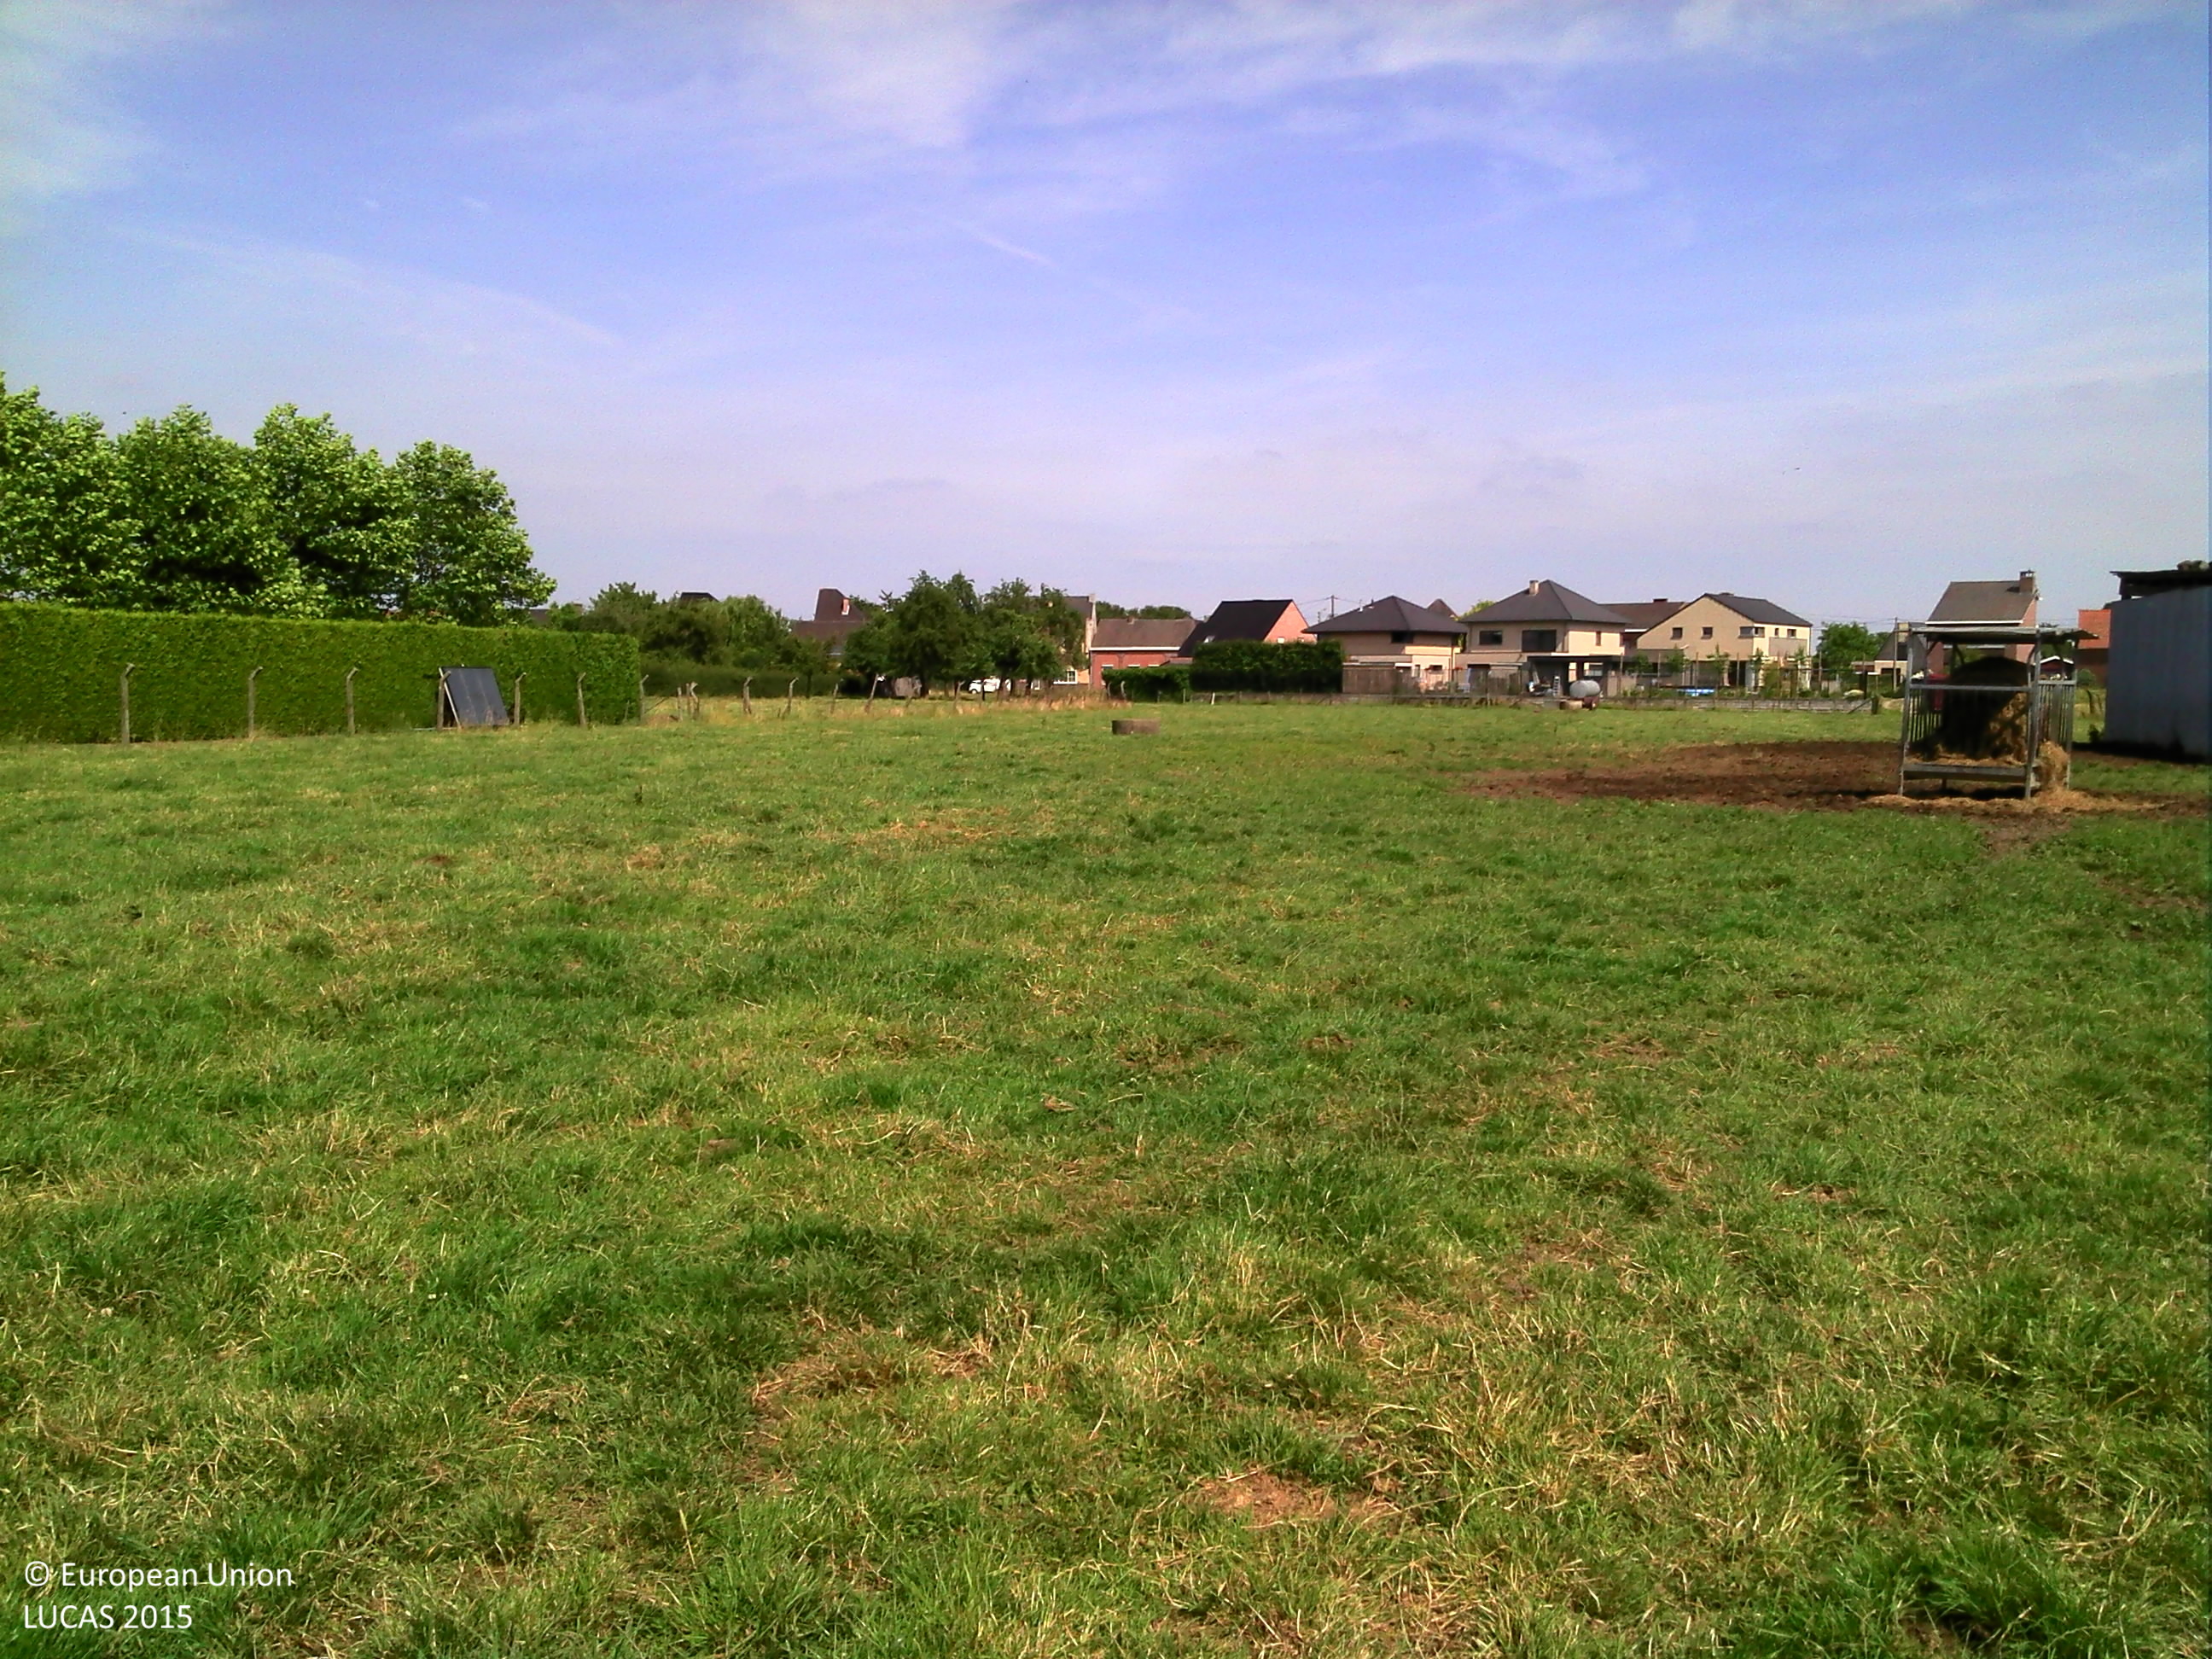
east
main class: Grassland
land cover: Grassland without tree/shrub cover
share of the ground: > 75 %
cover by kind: herbaceous plants 100 %
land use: Agriculture (excluding fallow land and kitchen gardens)
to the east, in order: Grassland without tree/shrub cover; Fences; Grassland with sparse tree/shrub cover; Artificial constructions in urban areas
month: June
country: BE
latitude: 50.8729
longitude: 5.5787
